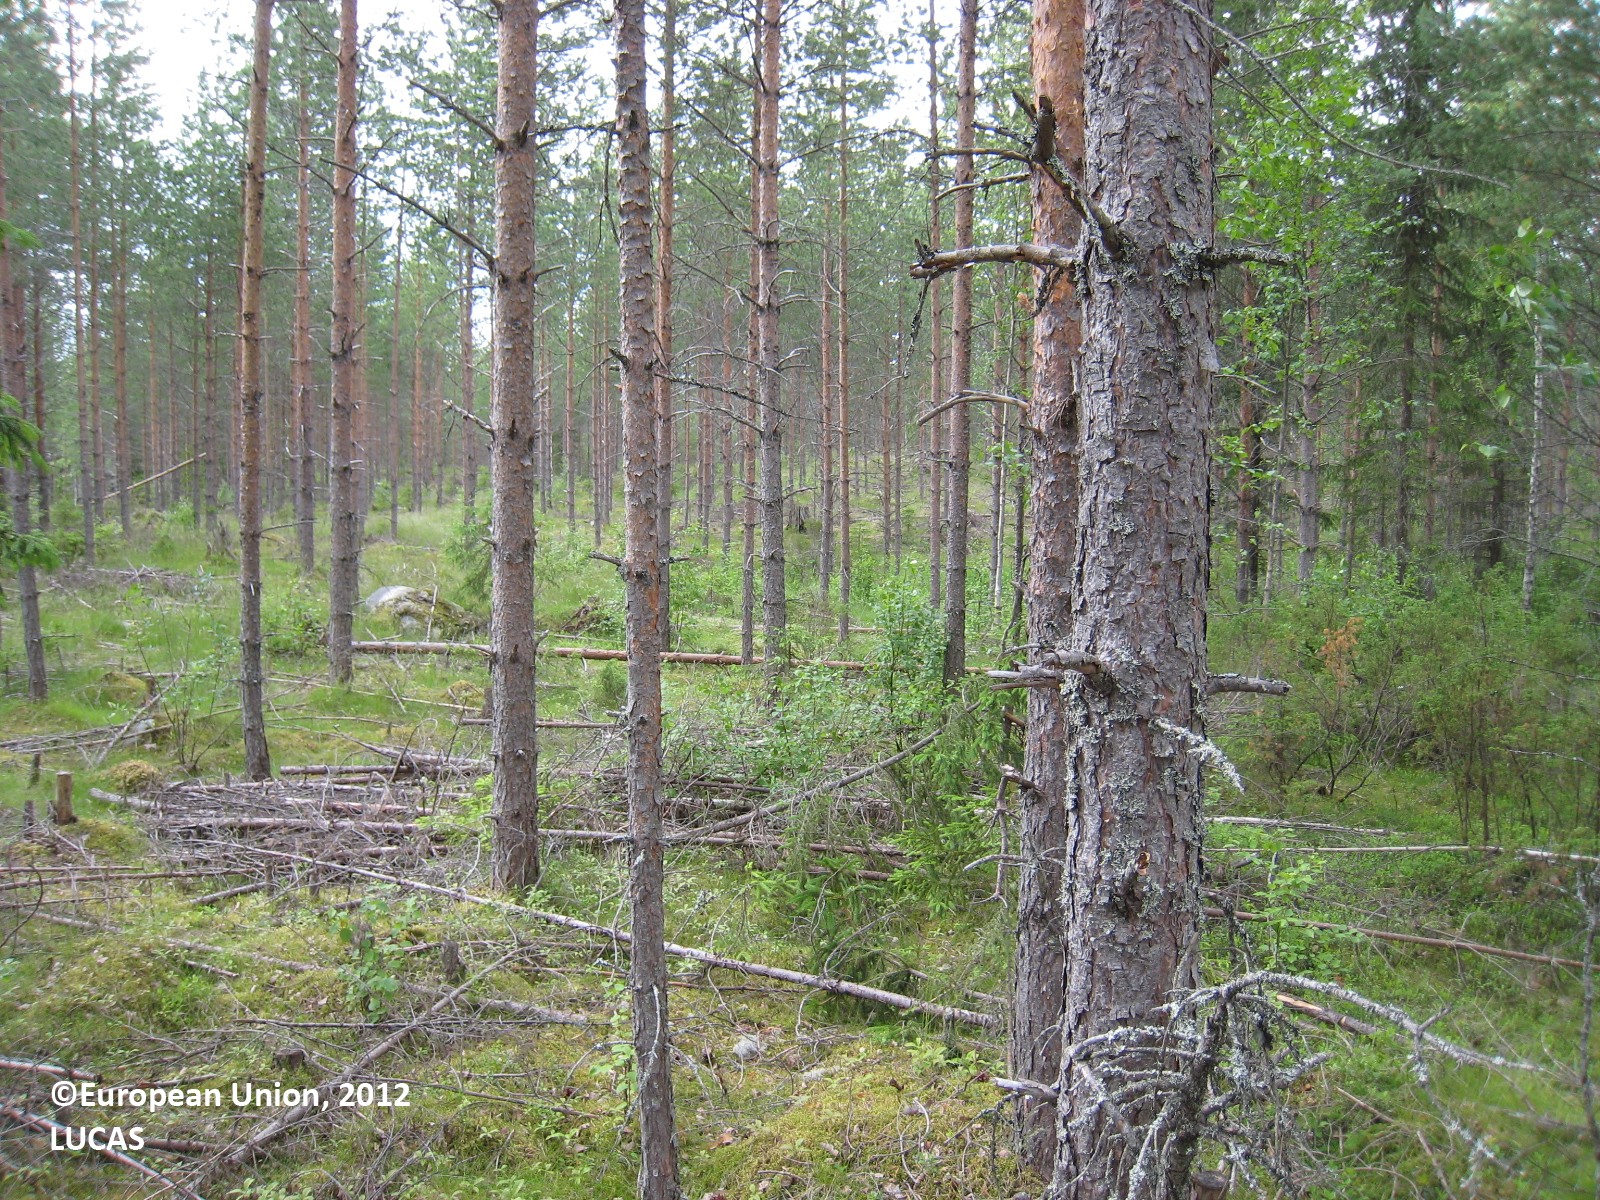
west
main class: Woodland
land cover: Pine dominated coniferous woodland
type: boreal forest
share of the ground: 50 - 75 %
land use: Forestry
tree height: > 5 m
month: June
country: FI
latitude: 62.1700
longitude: 26.3618
